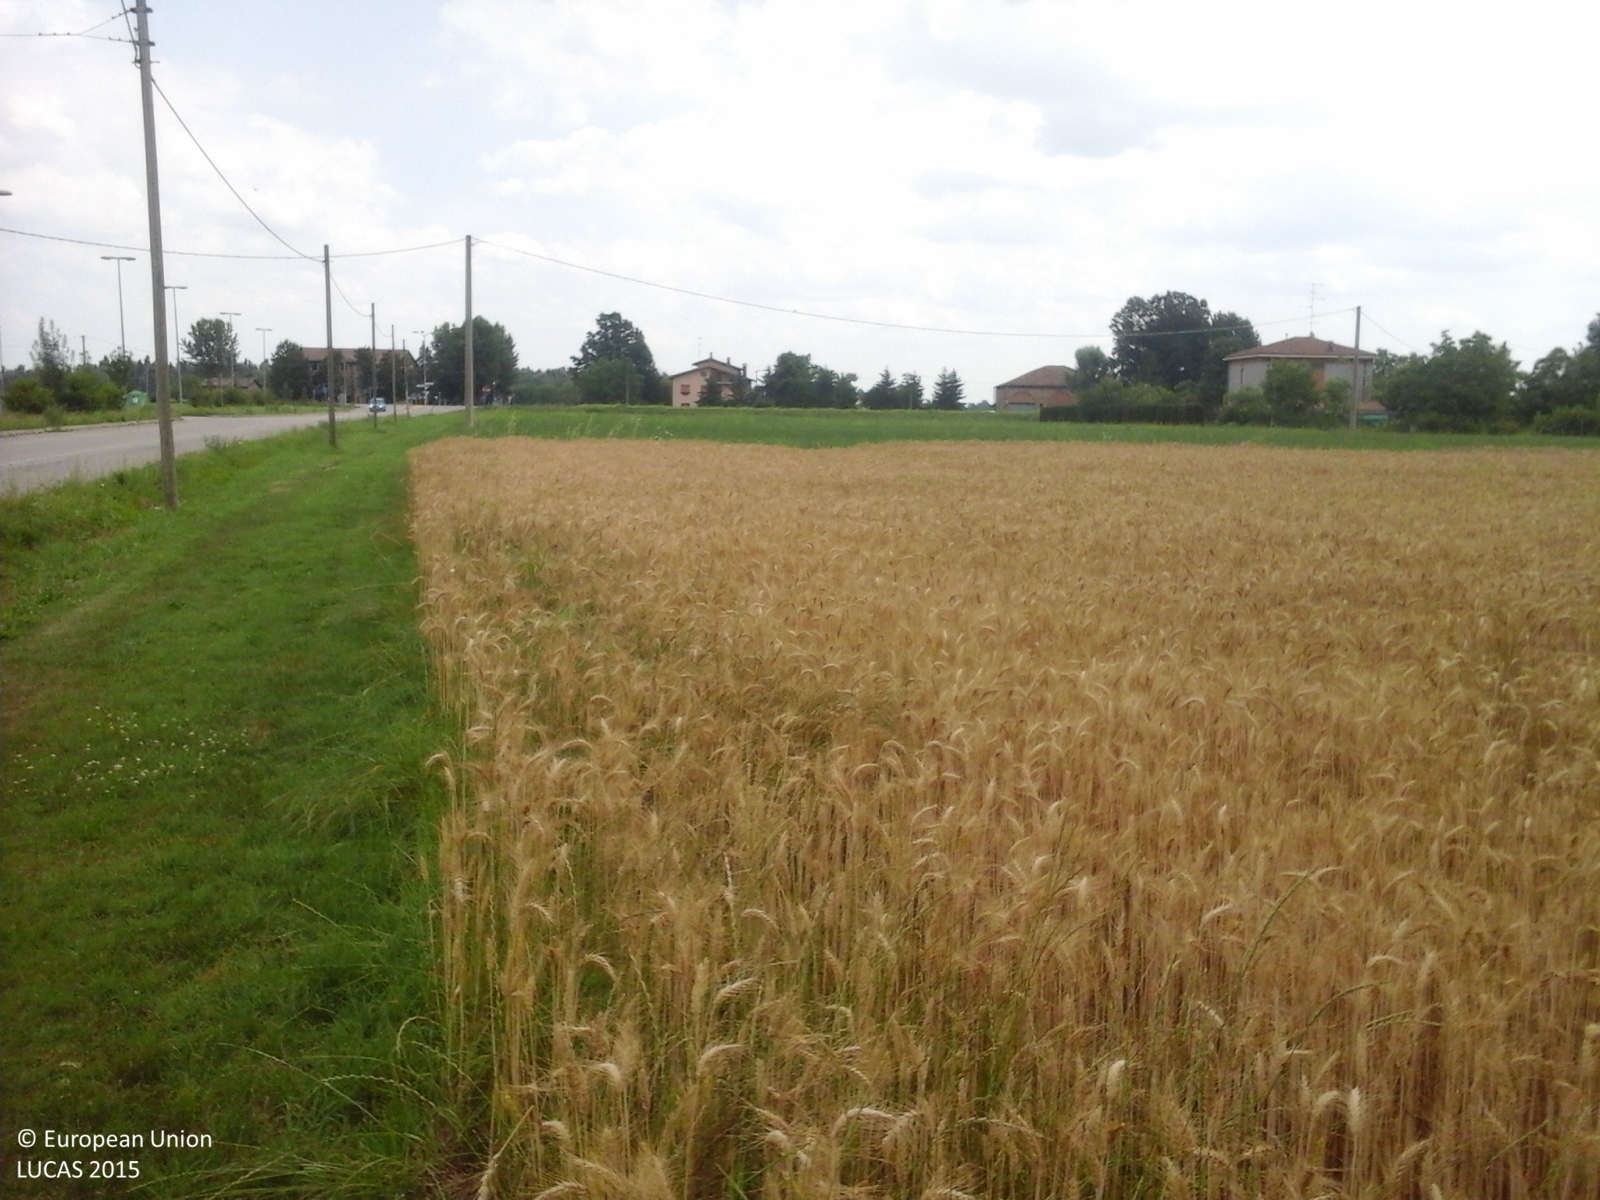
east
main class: Woodland
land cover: Broadleaved woodland
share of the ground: > 75 %
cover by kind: broadleaved forest trees 90 %, herbaceous plants 10 %
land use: Residential
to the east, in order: Broadleaved woodland; Fences; Lines of trees; Grass margins; Ditches and canals; Grass margins; Common wheat; Grass margins; Ditches and canals; Grass margins; Lucerne; Electric lines; Lucerne; Tracks; Ditches and canals; Grass margins; Lucerne; Grassland without tree/shrub cover; Paved roads, cycling and walking lanes
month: June
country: IT
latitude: 44.7784
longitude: 11.0215
